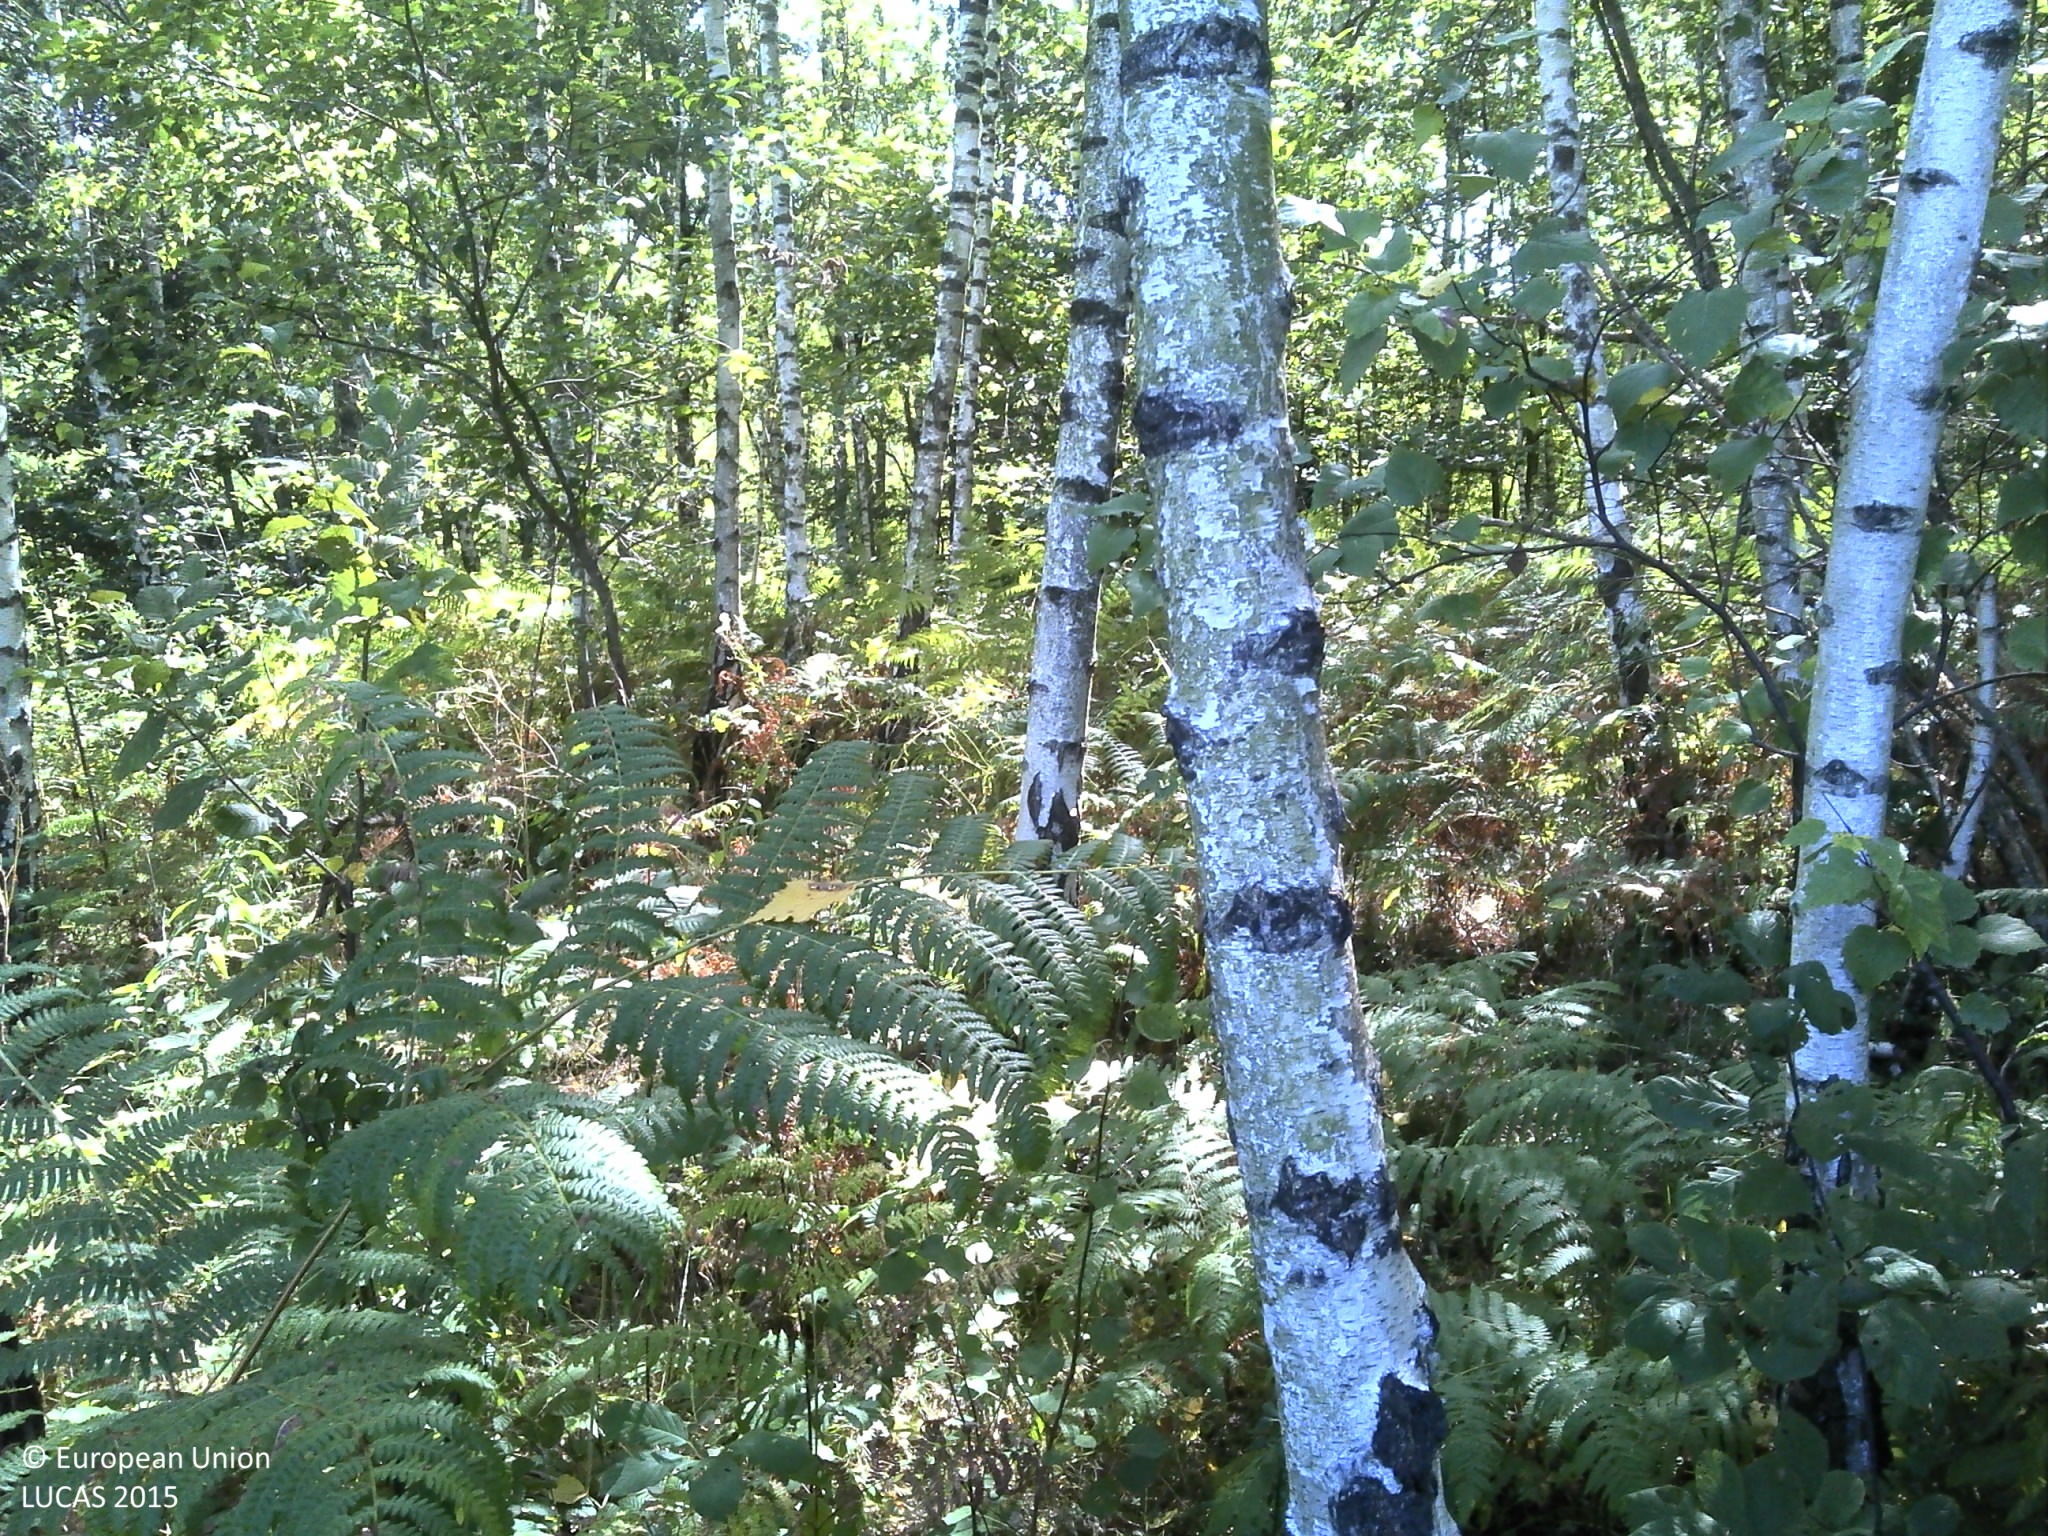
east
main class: Woodland
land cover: Broadleaved woodland
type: non-riverine alder, birch or aspen forest
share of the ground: > 75 %
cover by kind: broadleaved forest trees 100 %
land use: Forestry
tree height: > 5 m
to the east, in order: Broadleaved woodland
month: August
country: HR
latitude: 45.2704
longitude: 16.4595
